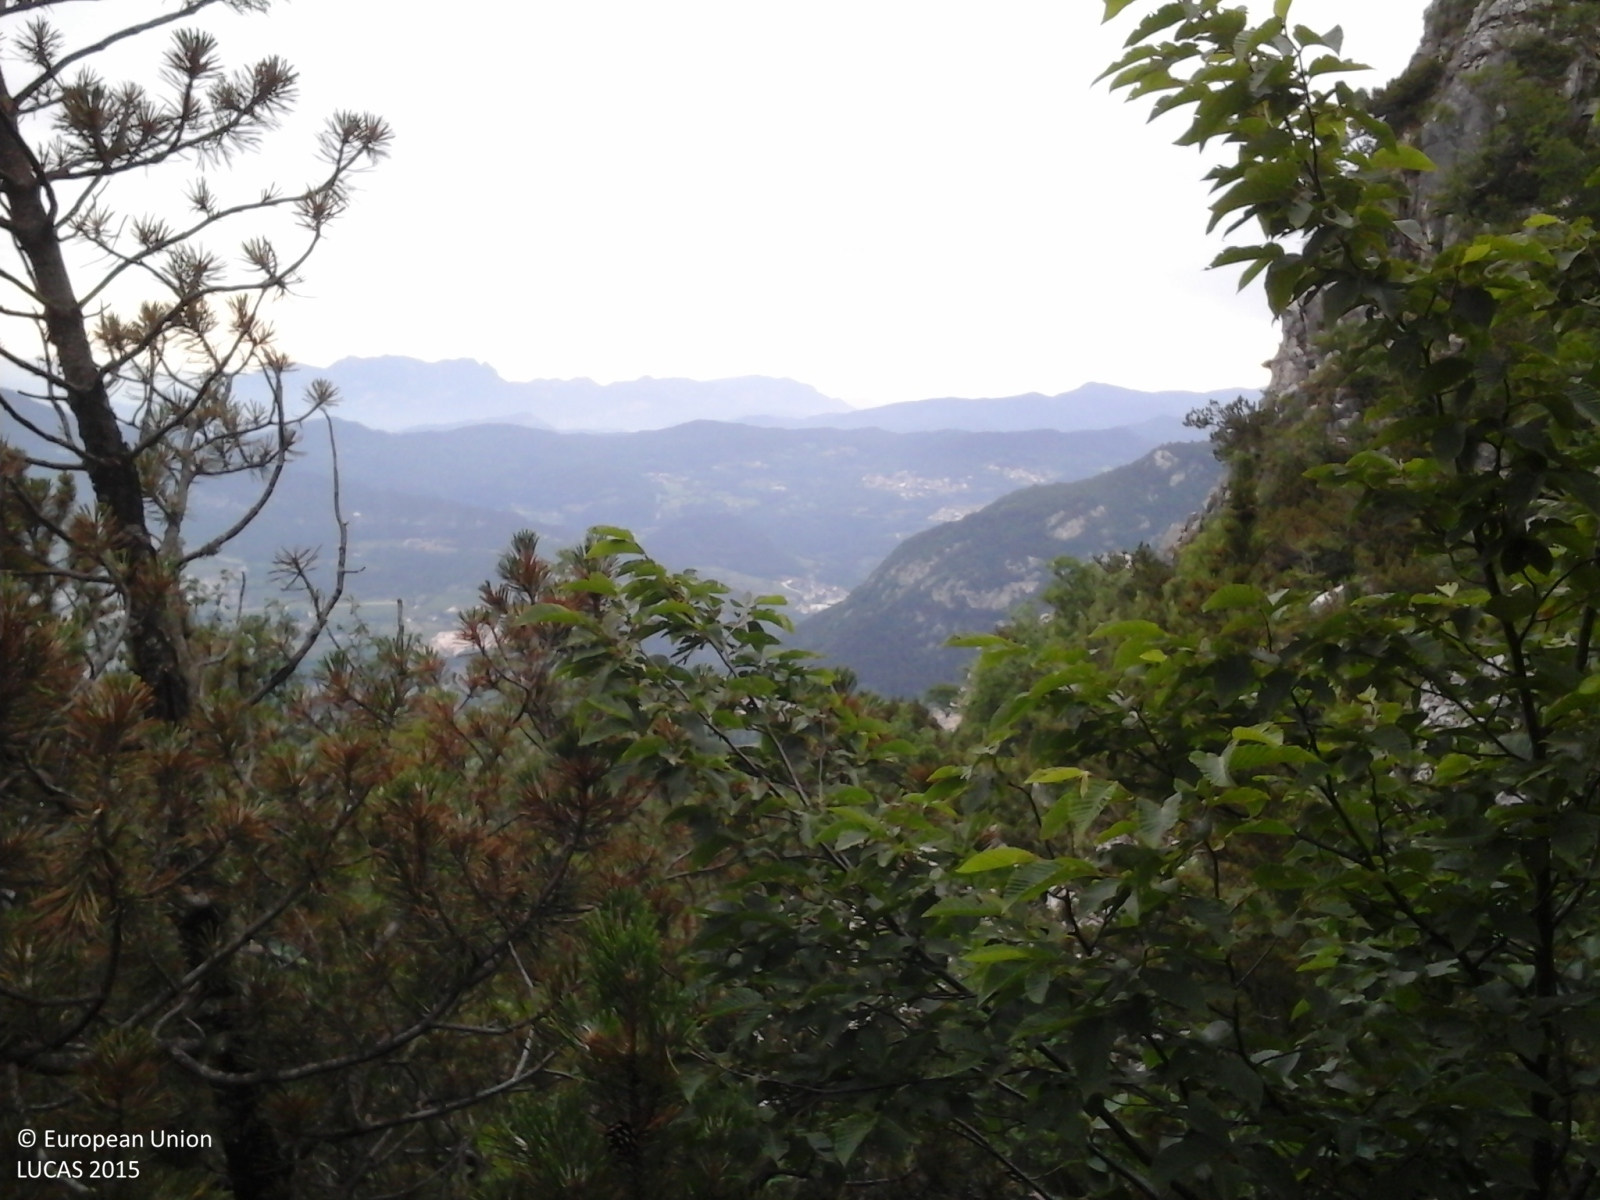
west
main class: Woodland
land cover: Other mixed woodland
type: alpine coniferous forest
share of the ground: > 75 %
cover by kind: broadleaved forest trees 60 %, coniferous forest trees 40 %
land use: Forestry
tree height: > 5 m
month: June
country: IT
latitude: 46.0565
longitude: 11.1745
